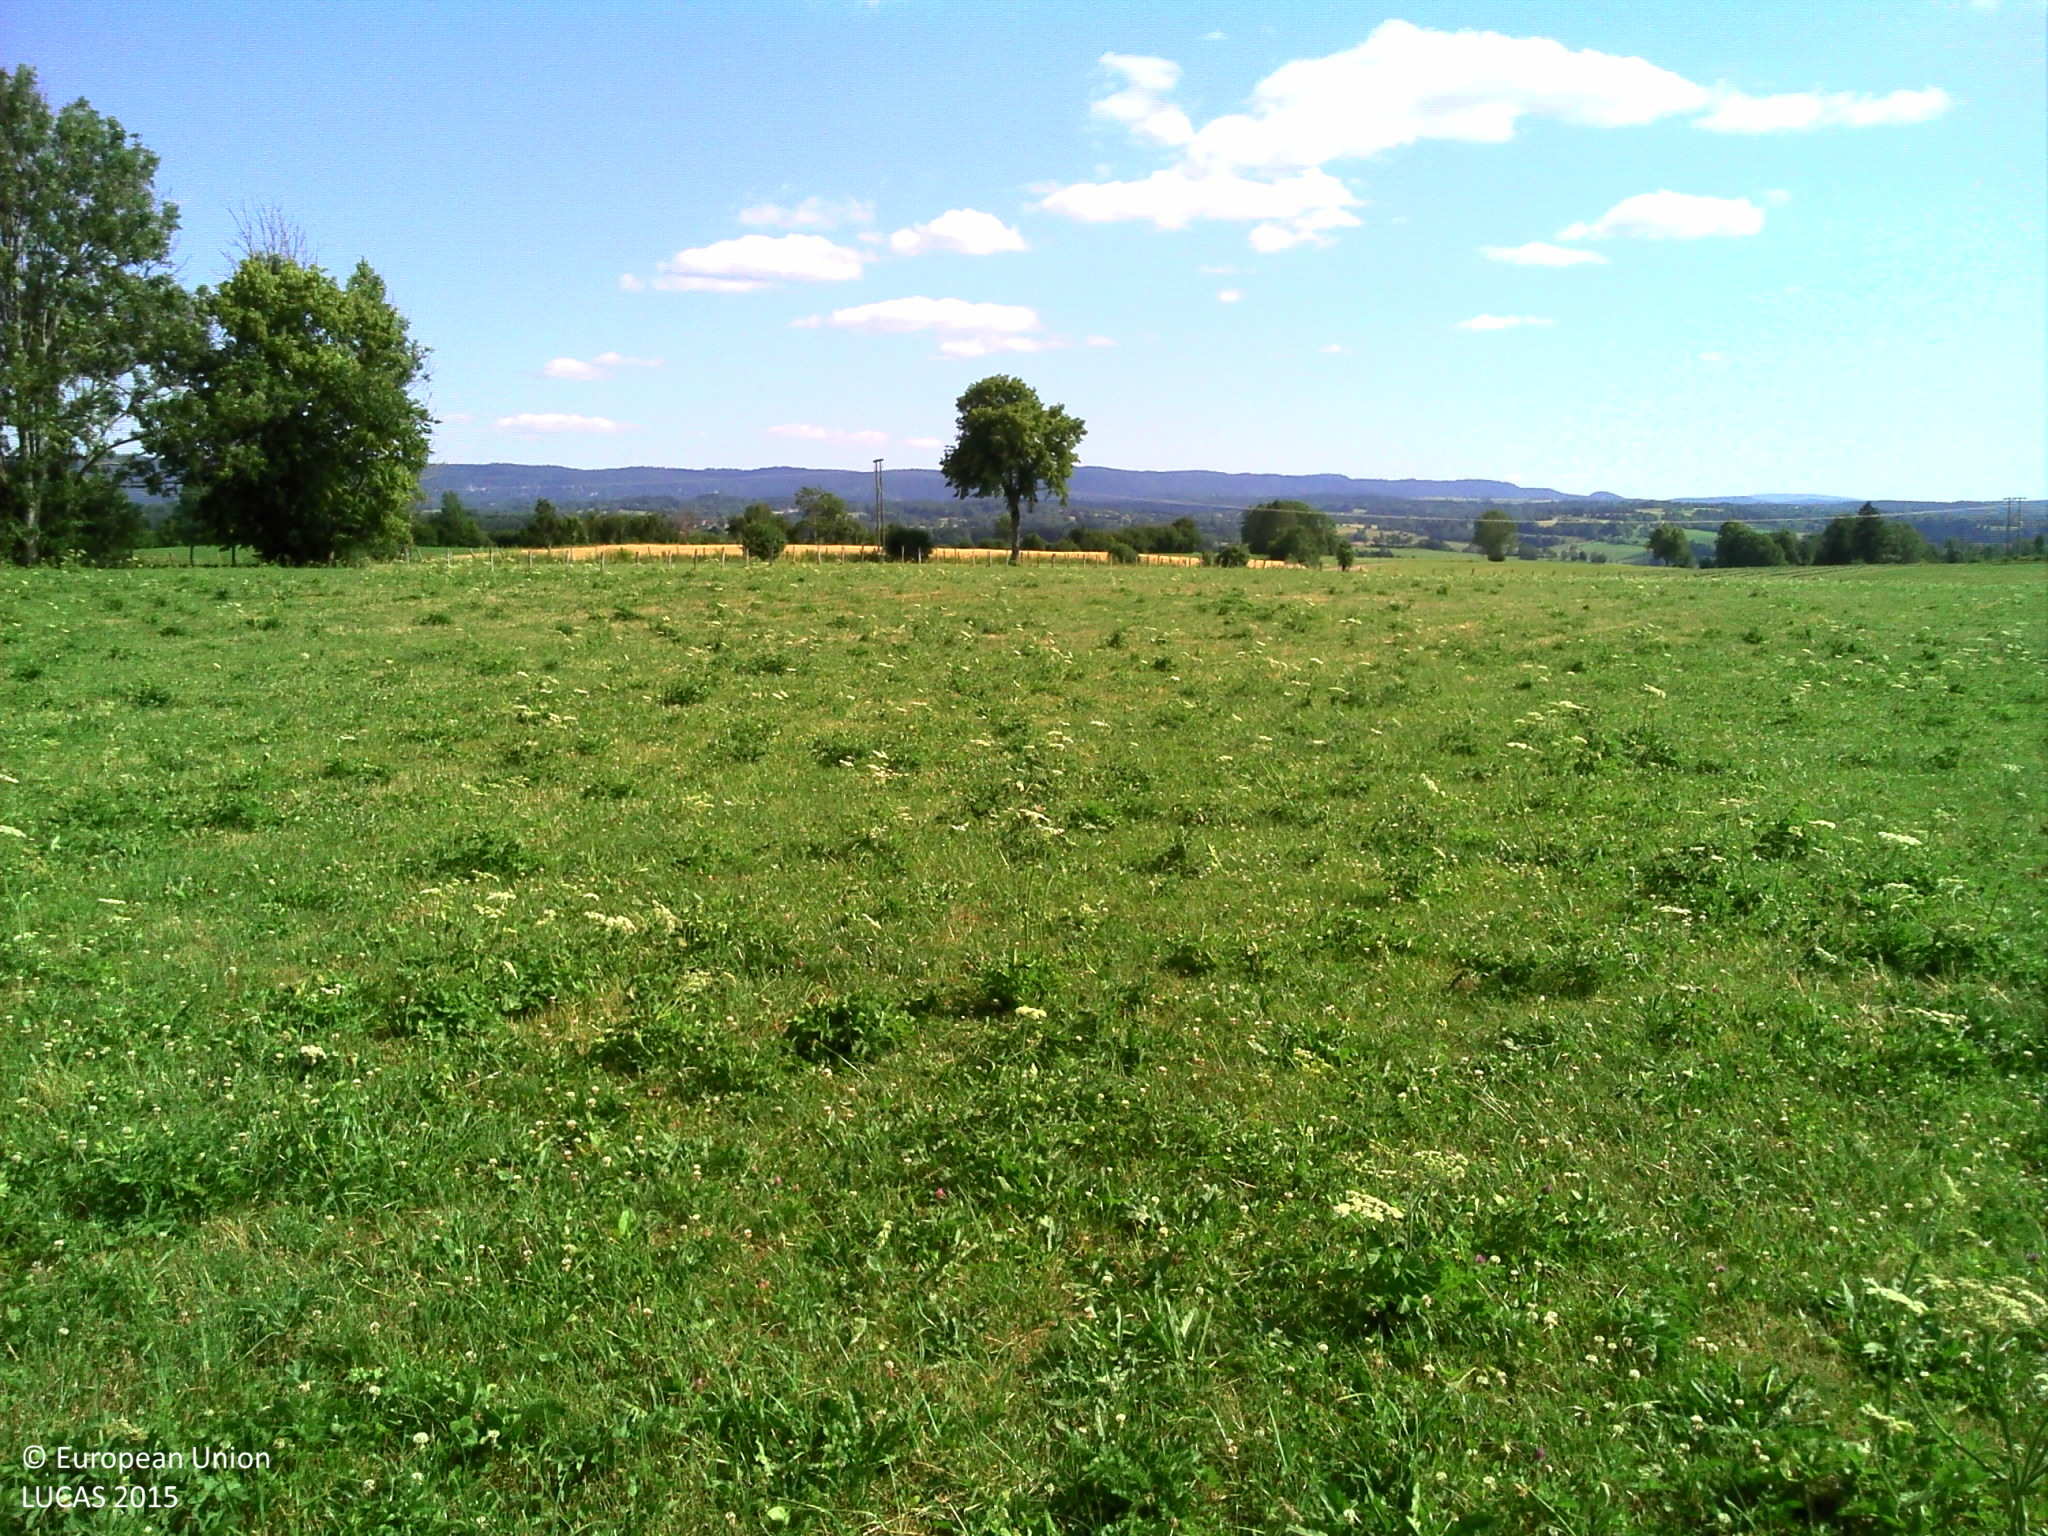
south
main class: Grassland
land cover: Grassland without tree/shrub cover
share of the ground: > 75 %
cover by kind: herbaceous plants 100 %
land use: Agriculture (excluding fallow land and kitchen gardens)
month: July
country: FR
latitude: 46.8015
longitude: 6.0585
